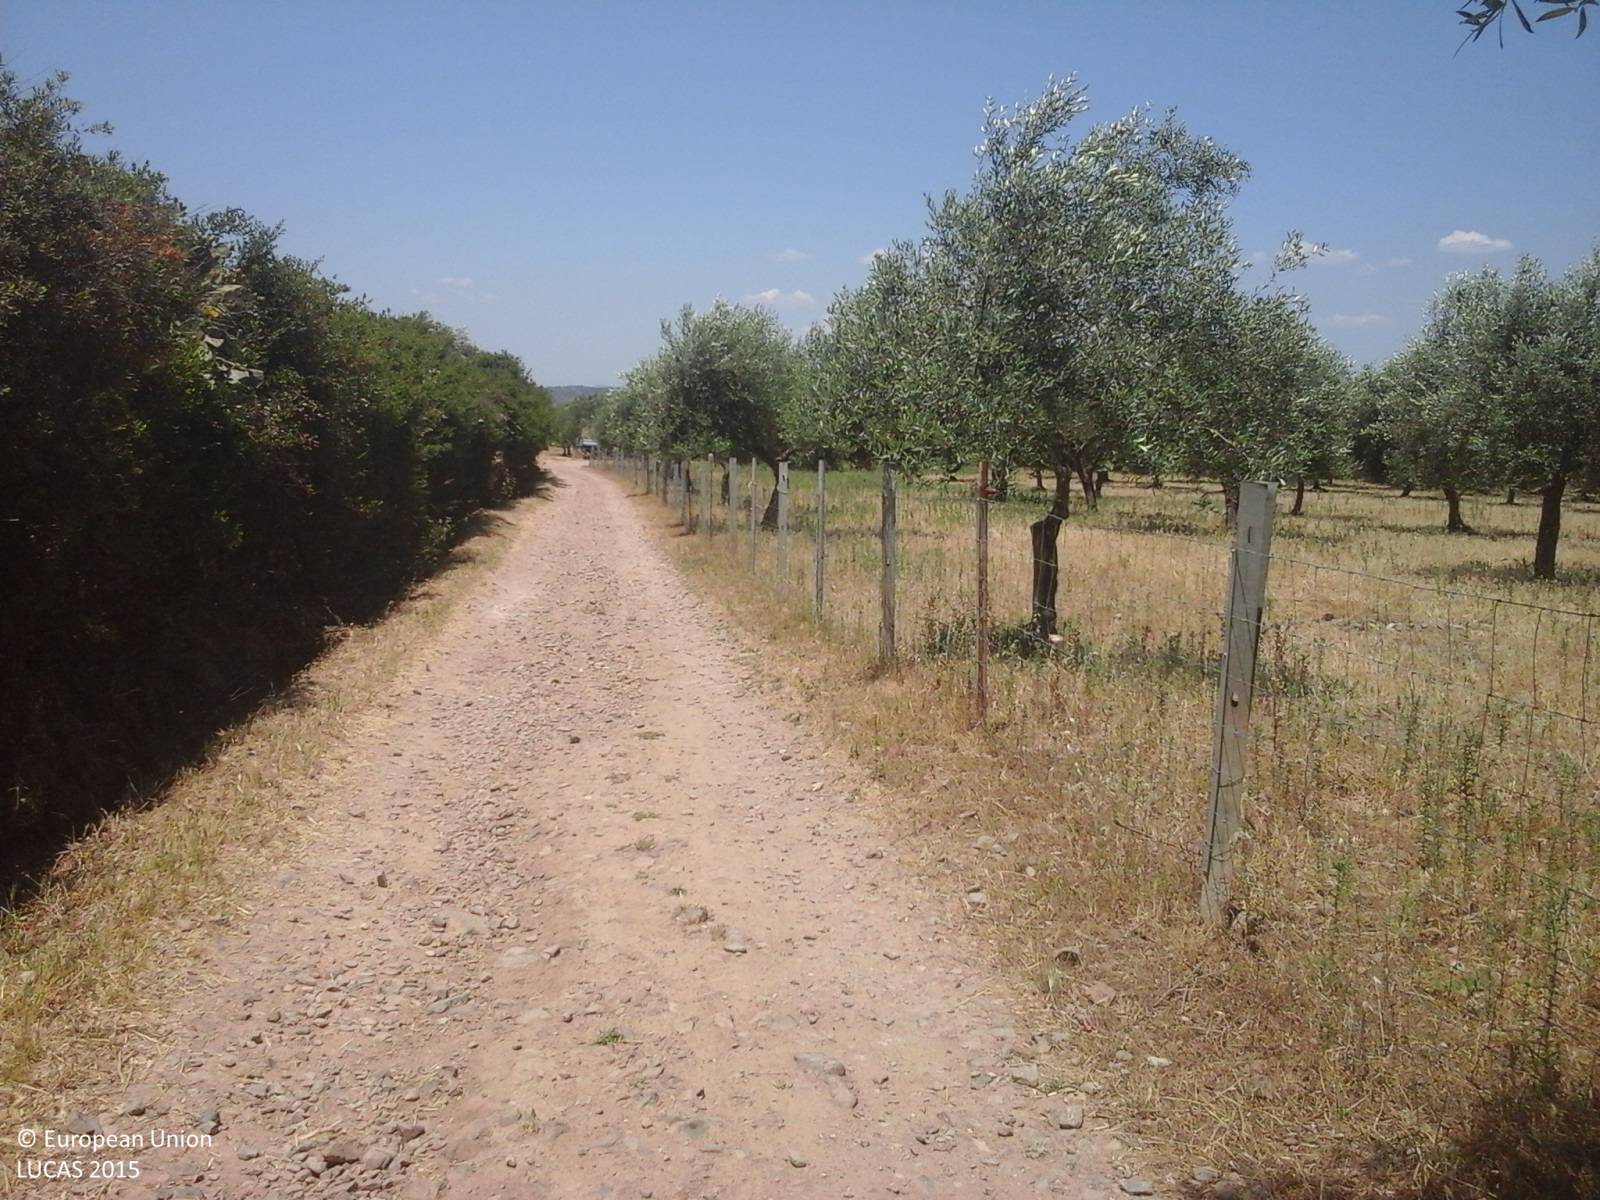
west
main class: Cropland
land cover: Olive groves
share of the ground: > 75 %
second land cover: Grassland without tree/shrub cover
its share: > 75 %
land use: Agriculture (excluding fallow land and kitchen gardens)
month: June
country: IT
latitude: 39.3766
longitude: 9.2039
